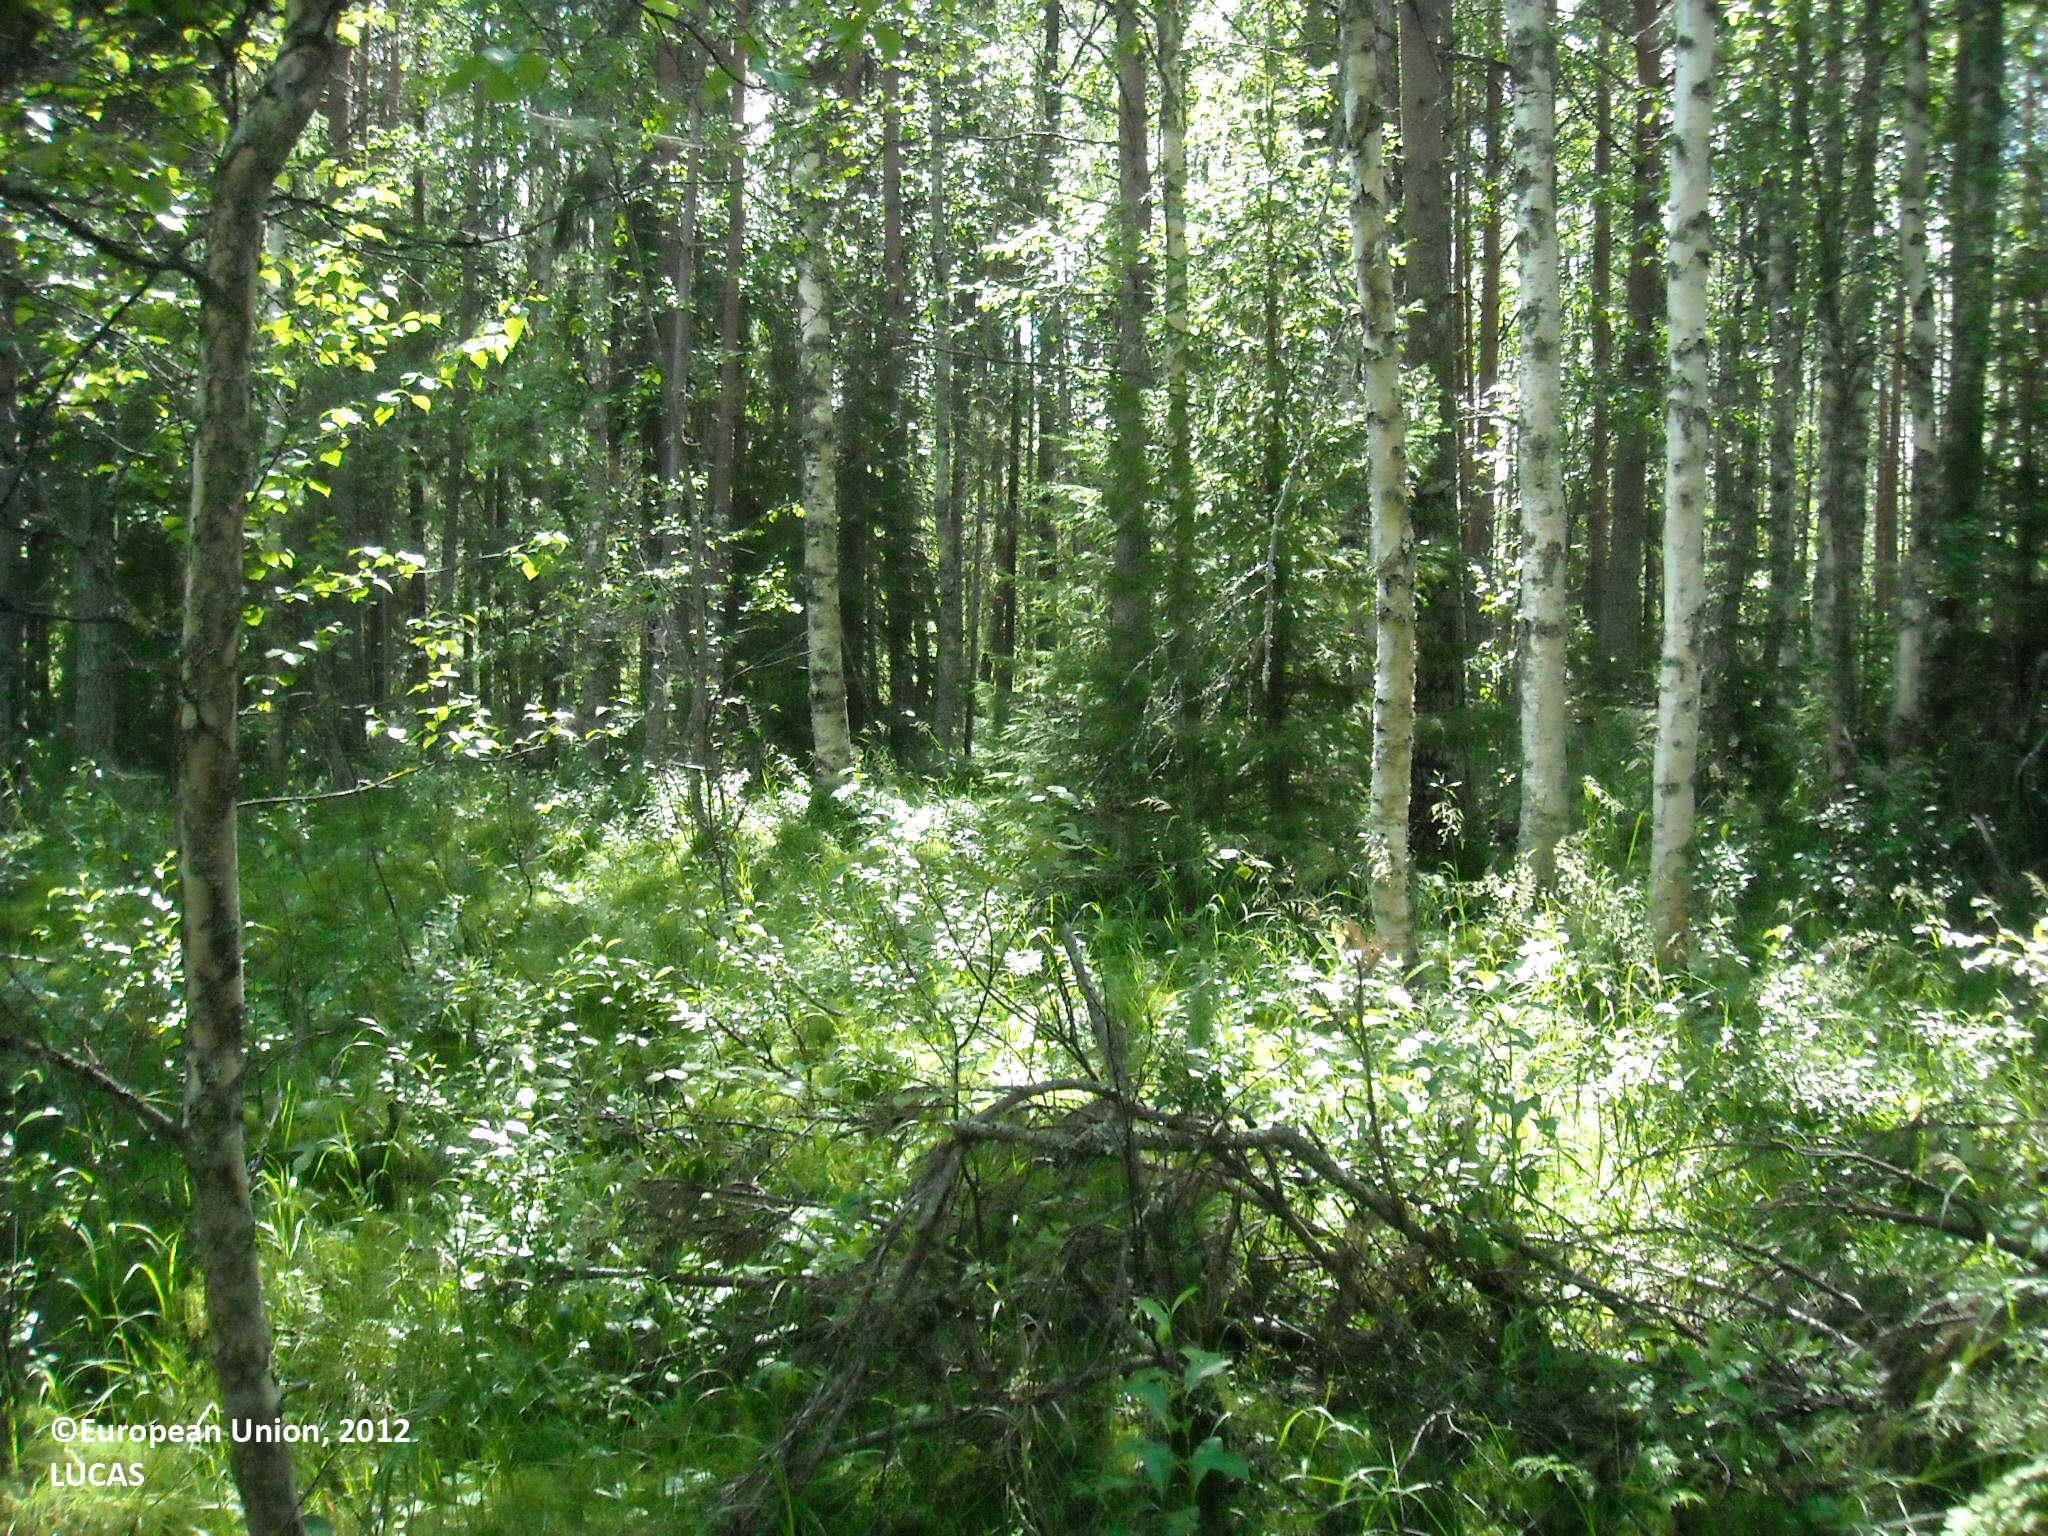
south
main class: Woodland
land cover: Broadleaved woodland
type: boreal forest
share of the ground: > 75 %
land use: Forestry
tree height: > 5 m
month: July
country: FI
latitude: 64.9441
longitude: 26.9450
